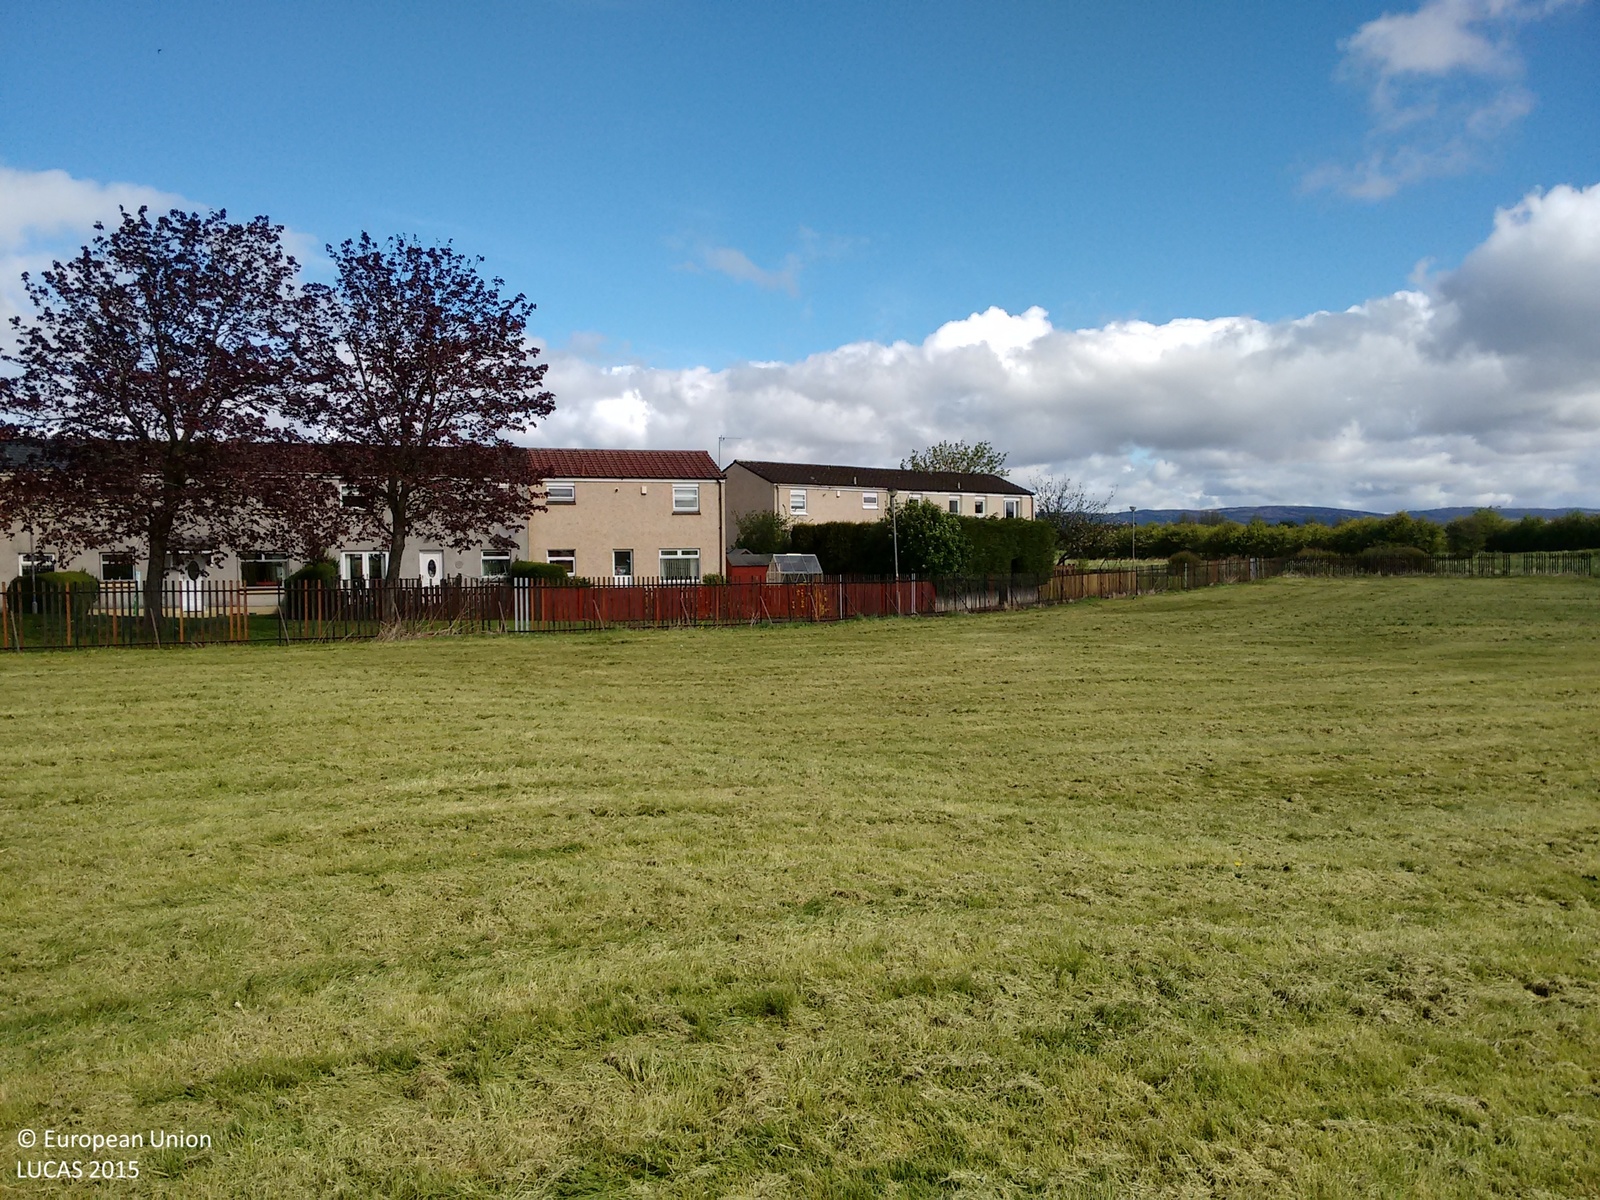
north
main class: Grassland
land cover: Grassland without tree/shrub cover
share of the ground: > 75 %
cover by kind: herbaceous plants 100 %
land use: Sport
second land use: Community services
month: May
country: GB
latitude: 55.8531
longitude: -4.4912
